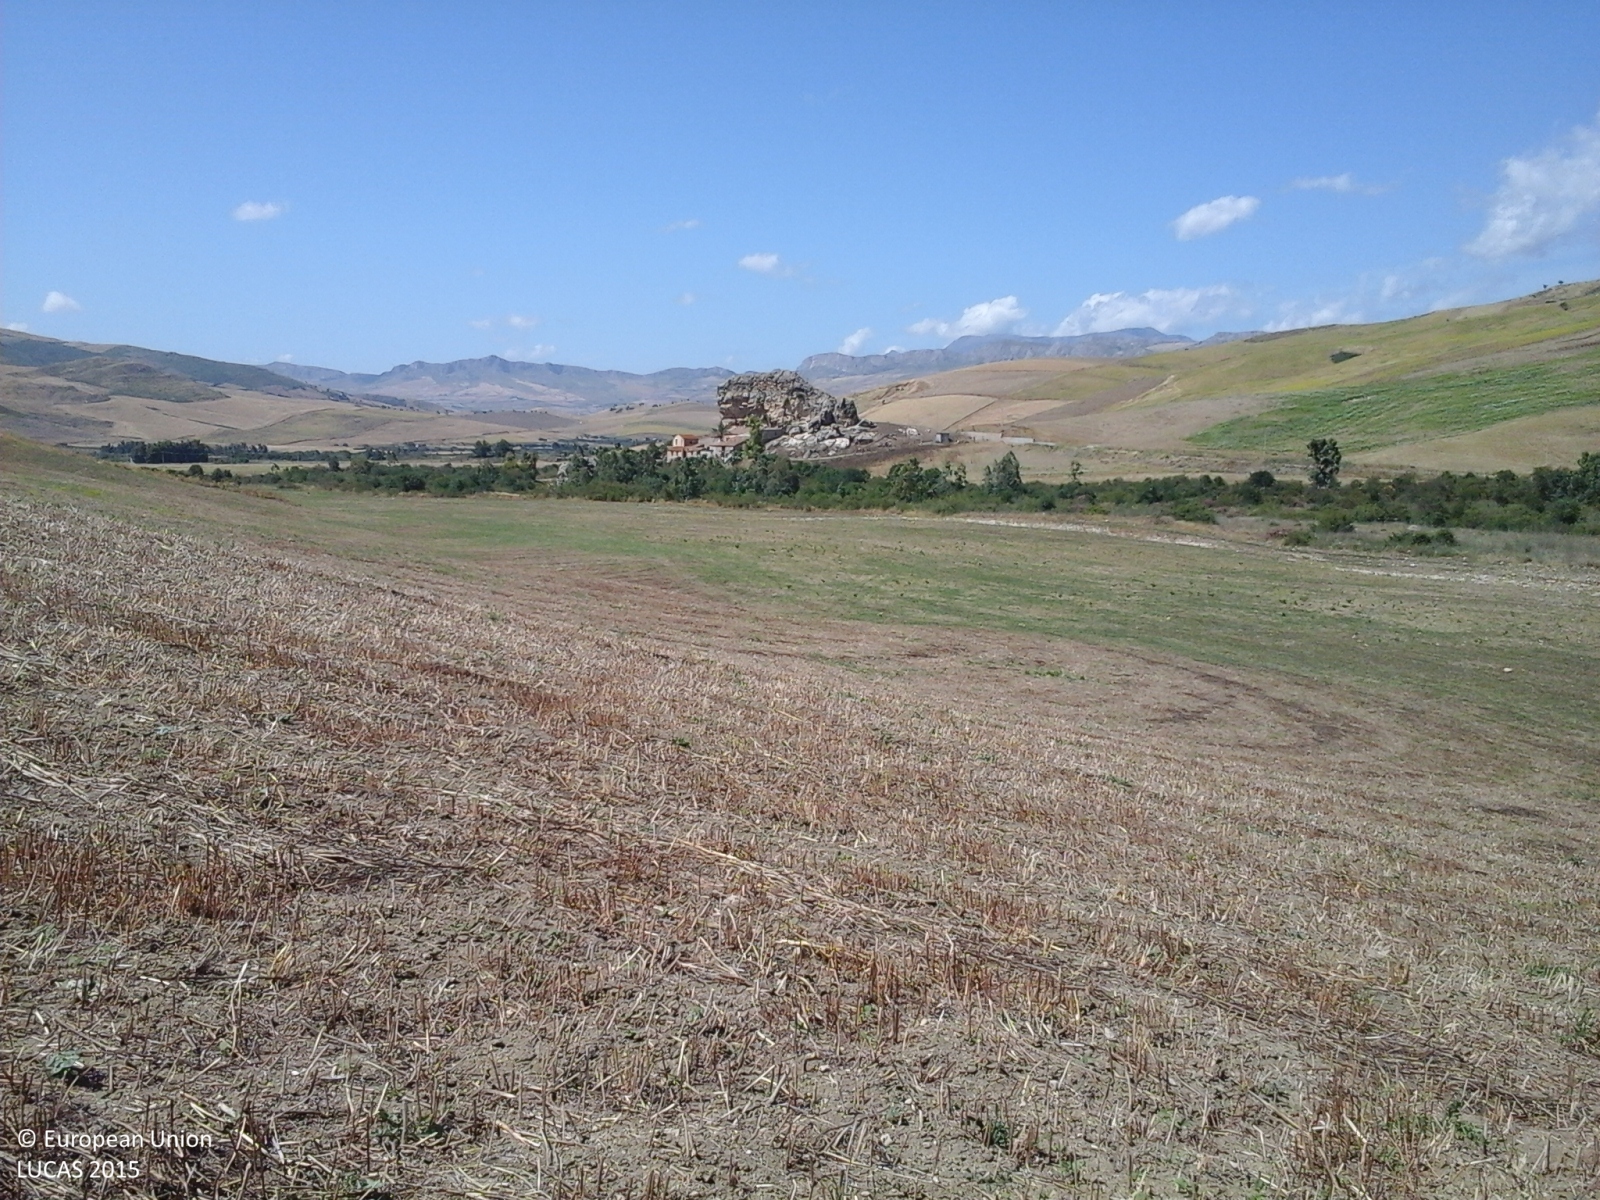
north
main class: Grassland
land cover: Grassland with sparse tree/shrub cover
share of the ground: > 75 %
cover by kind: herbaceous plants 85 %, shrubs 10 %, broadleaved forest trees 5 %
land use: Agriculture (excluding fallow land and kitchen gardens)
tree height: < 5 m
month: June
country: IT
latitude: 37.7911
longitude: 13.5286
